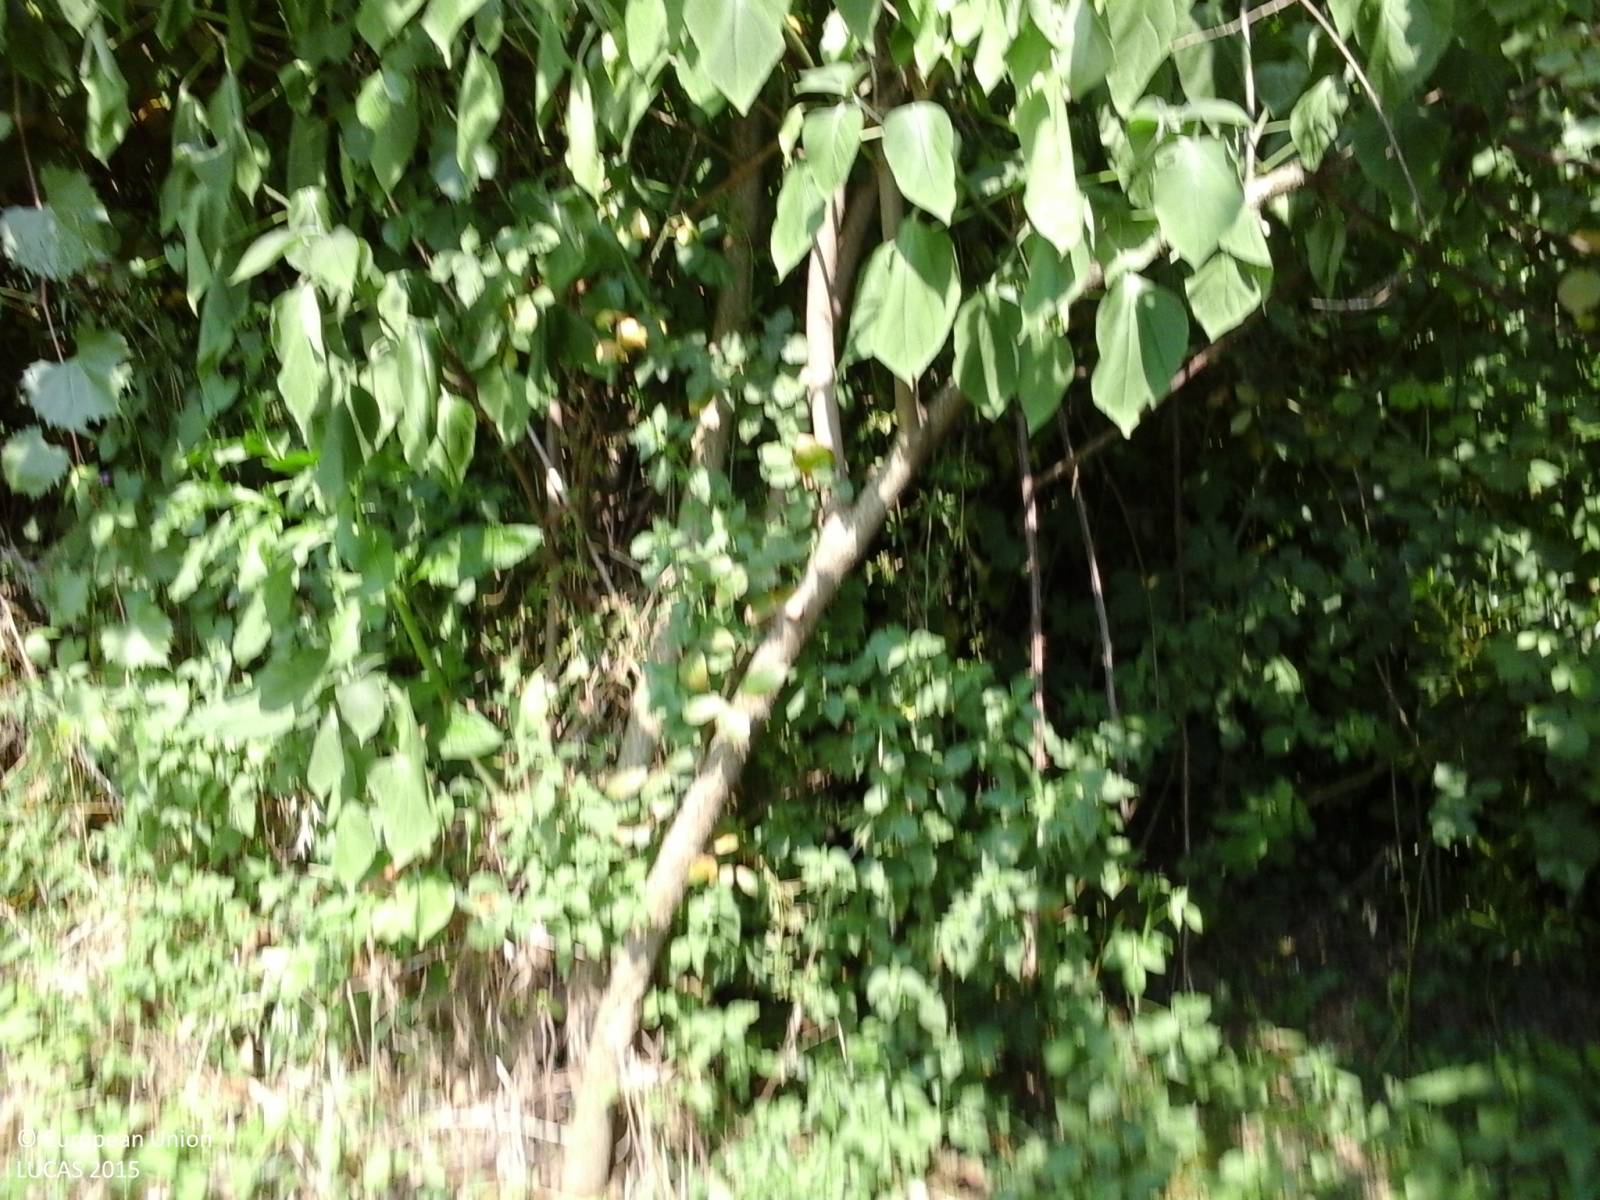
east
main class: Woodland
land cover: Broadleaved woodland
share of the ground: > 75 %
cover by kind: broadleaved forest trees 100 %
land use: Agriculture (excluding fallow land and kitchen gardens)
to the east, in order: Broadleaved woodland; Other fruit trees and berries; Vineyards; Paved roads, cycling and walking lanes; Fences; Abandoned hedges; Grassland without tree/shrub cover; Other fruit trees and berries
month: June
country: IT
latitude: 45.7445
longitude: 11.6042
